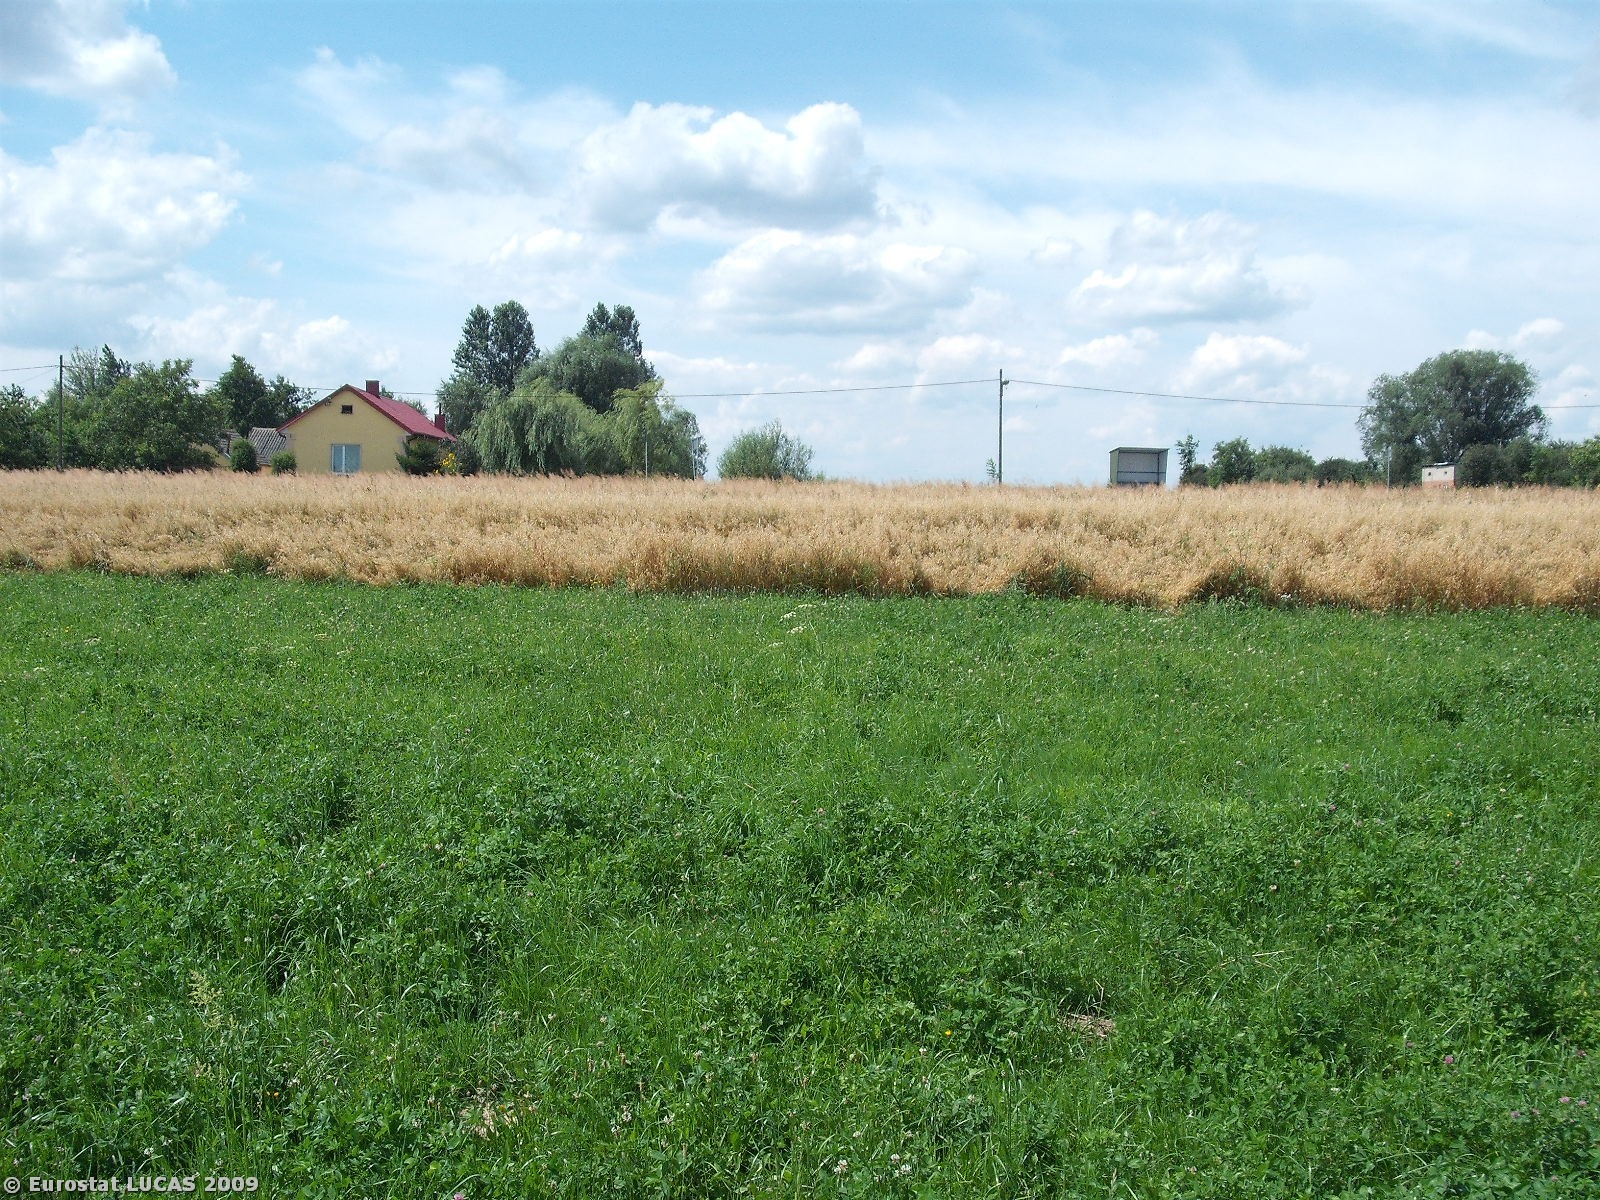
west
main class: Grassland
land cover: Grassland without tree/shrub cover
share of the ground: > 75 %
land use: Agriculture (excluding fallow land and kitchen gardens)
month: July
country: PL
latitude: 50.6795
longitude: 21.2417
